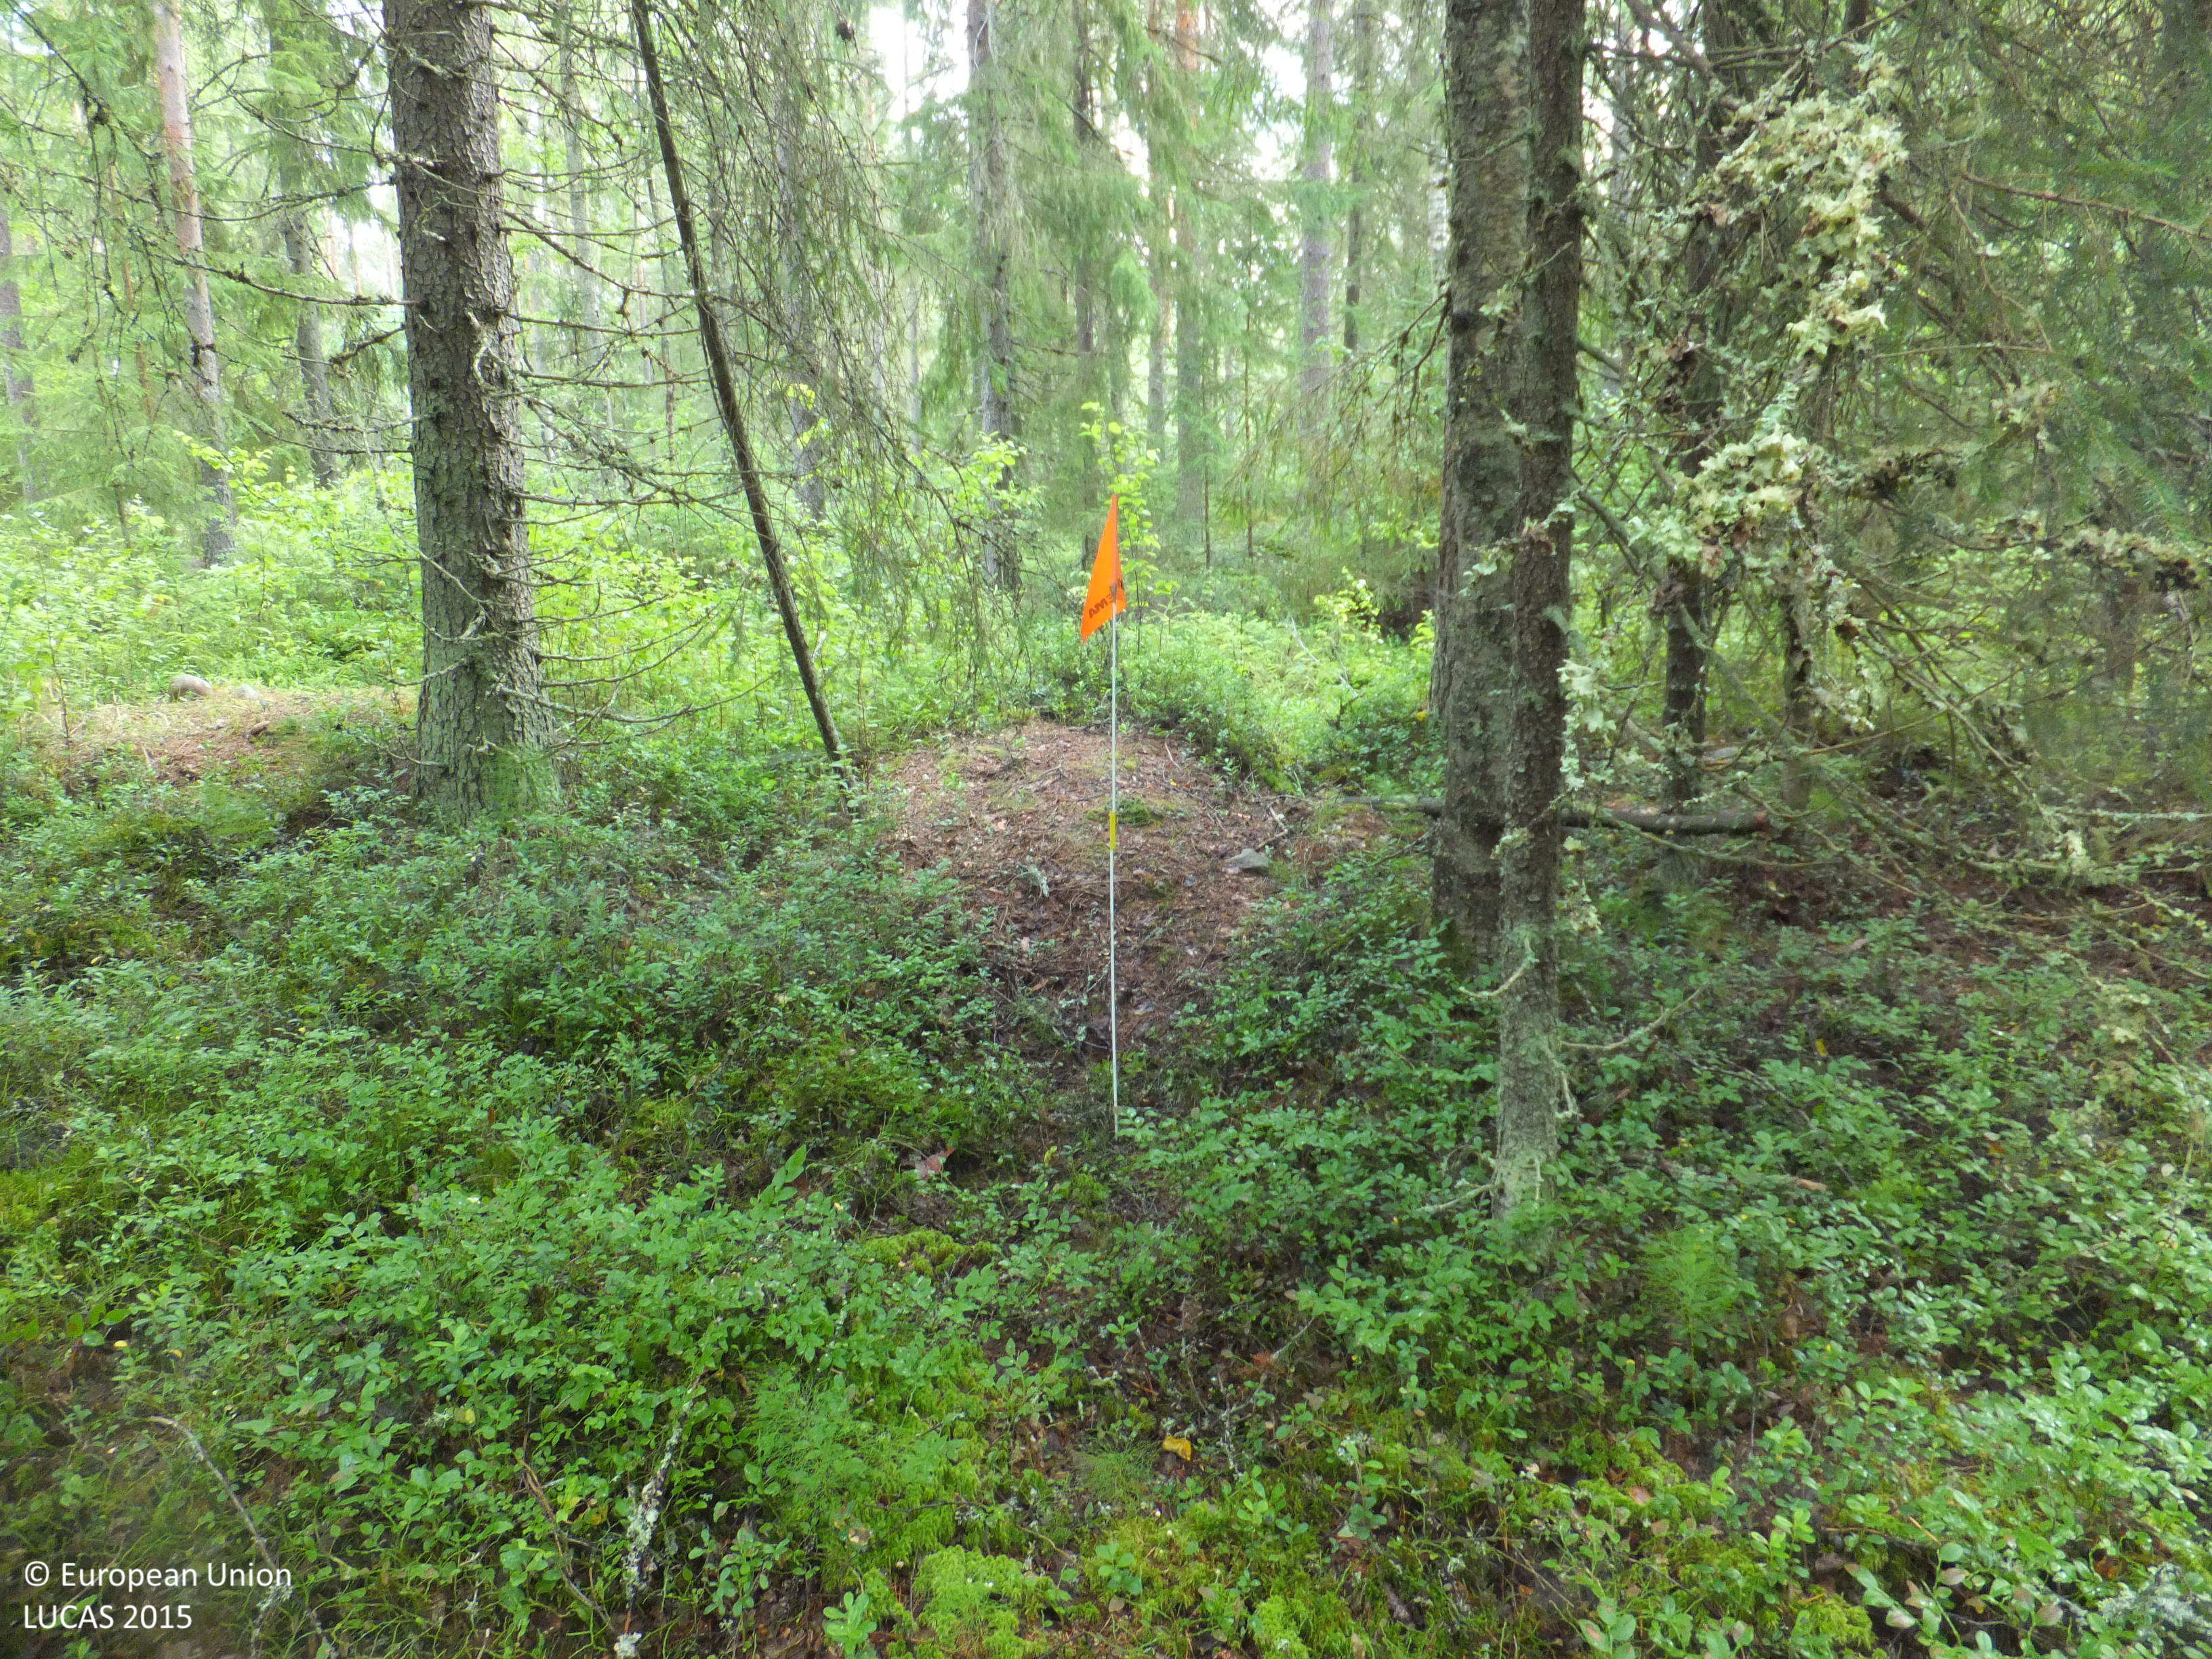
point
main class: Woodland
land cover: Other coniferous woodland
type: boreal forest
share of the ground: > 75 %
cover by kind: coniferous forest trees 85 %, broadleaved forest trees 5 %, shrubs 5 %, lichens and mosses 5 %
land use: Forestry
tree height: > 5 m
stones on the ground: < 10 %
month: July
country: FI
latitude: 63.1565
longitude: 21.9734
